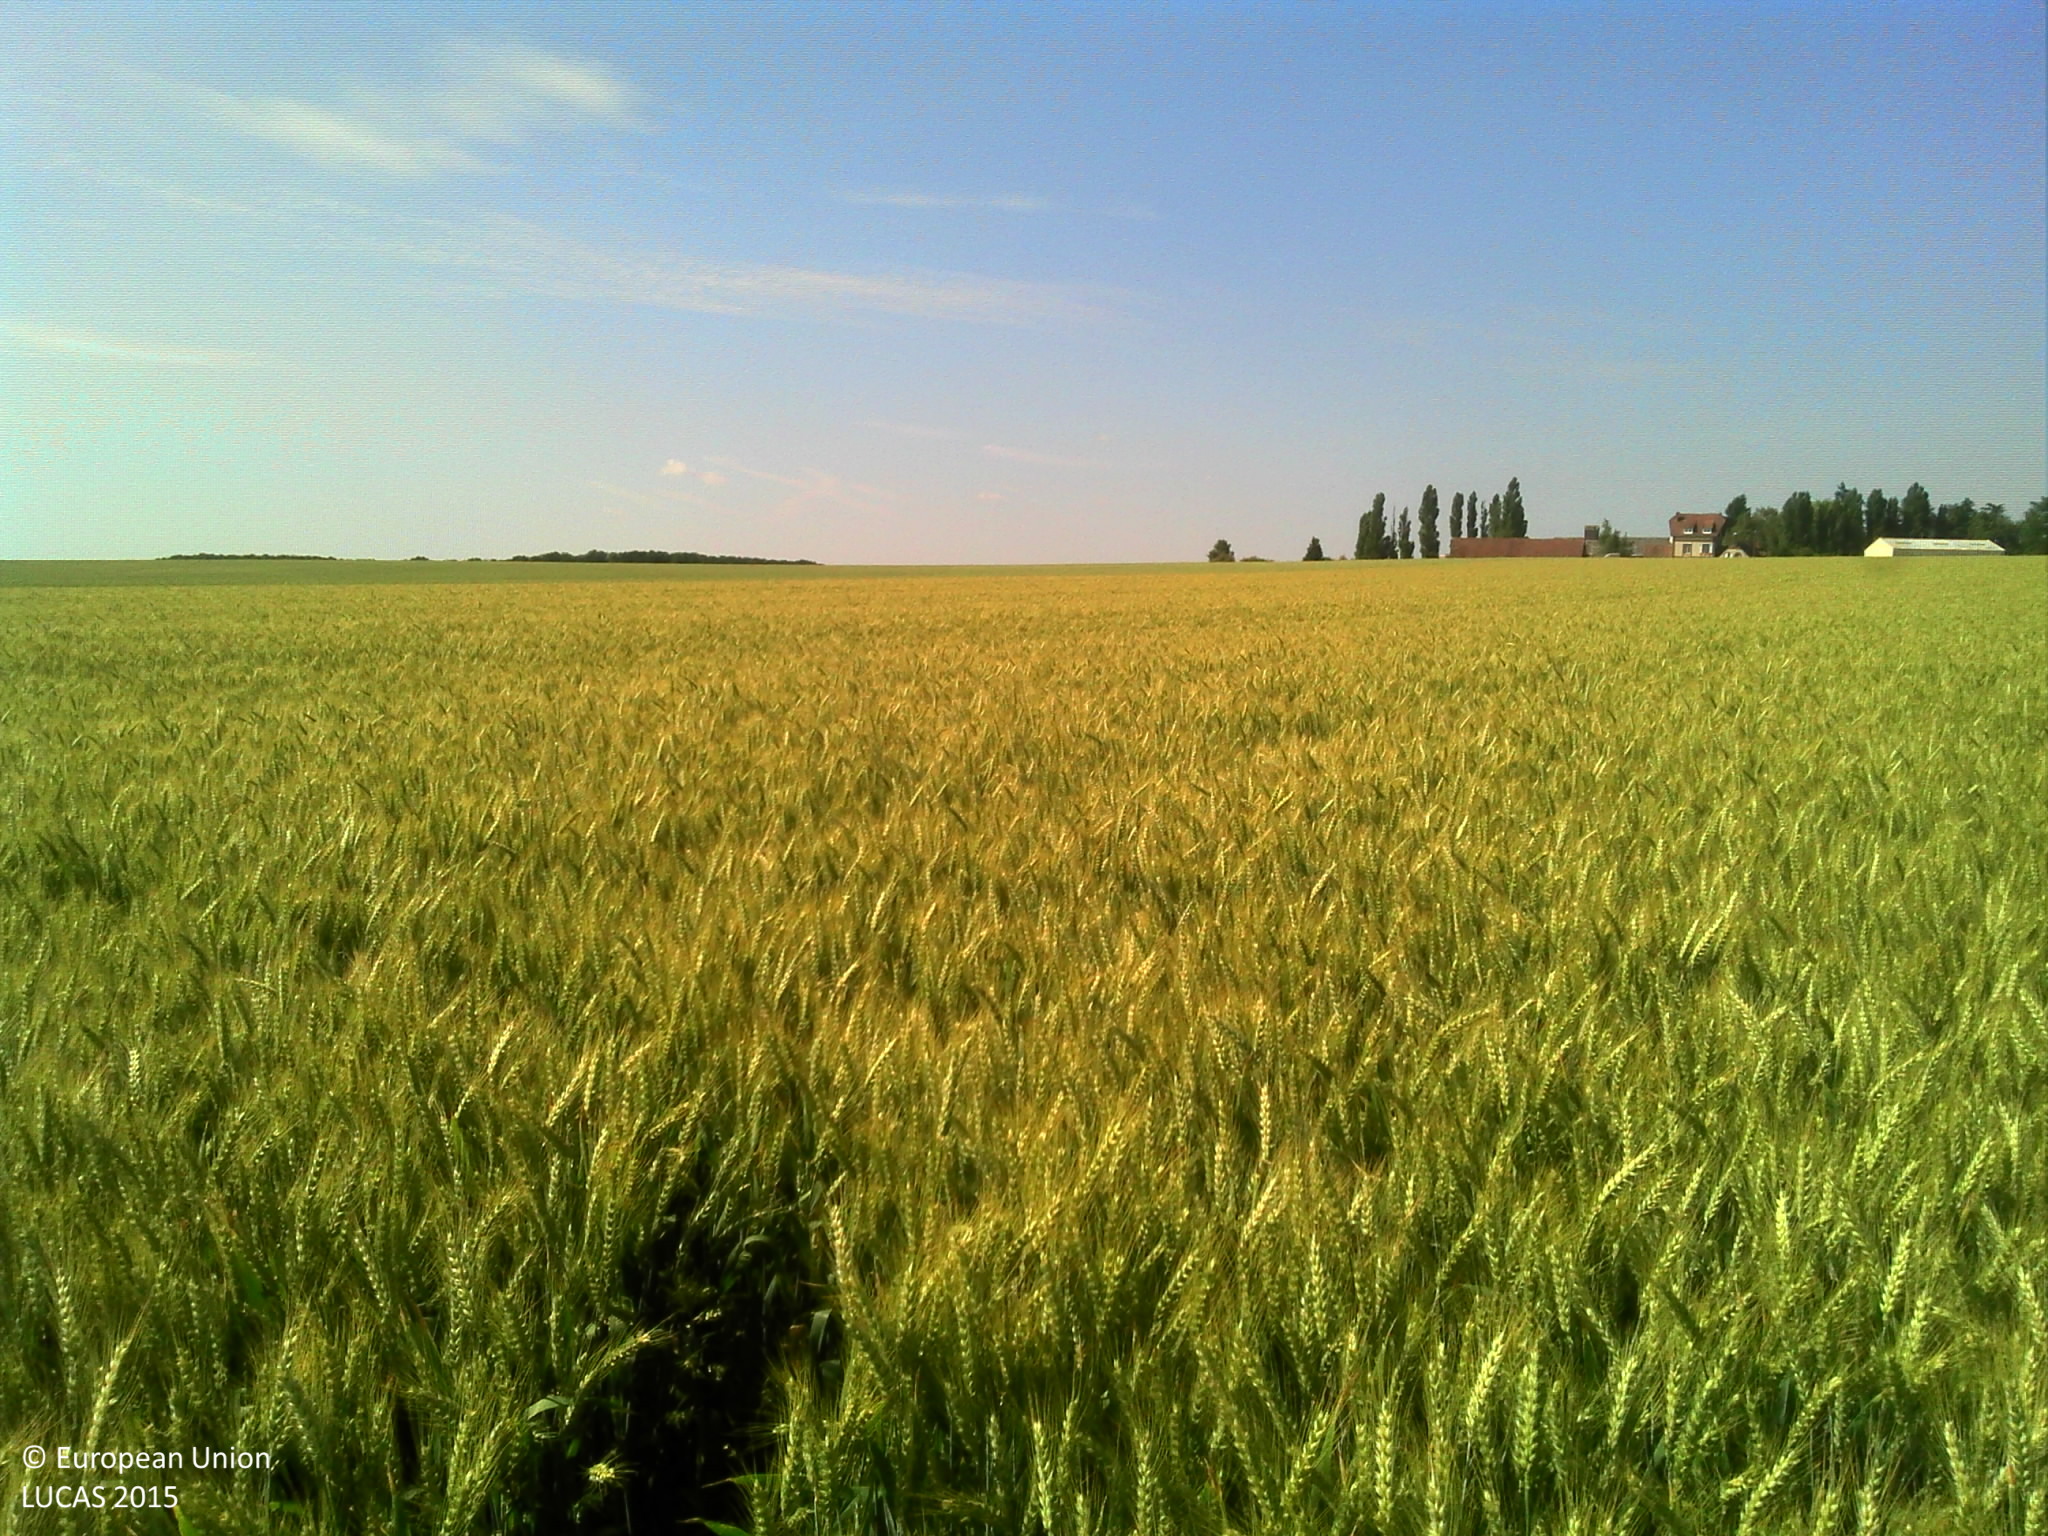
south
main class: Cropland
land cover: Common wheat
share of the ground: > 75 %
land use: Agriculture (excluding fallow land and kitchen gardens)
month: June
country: FR
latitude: 48.5391
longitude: 1.4090
